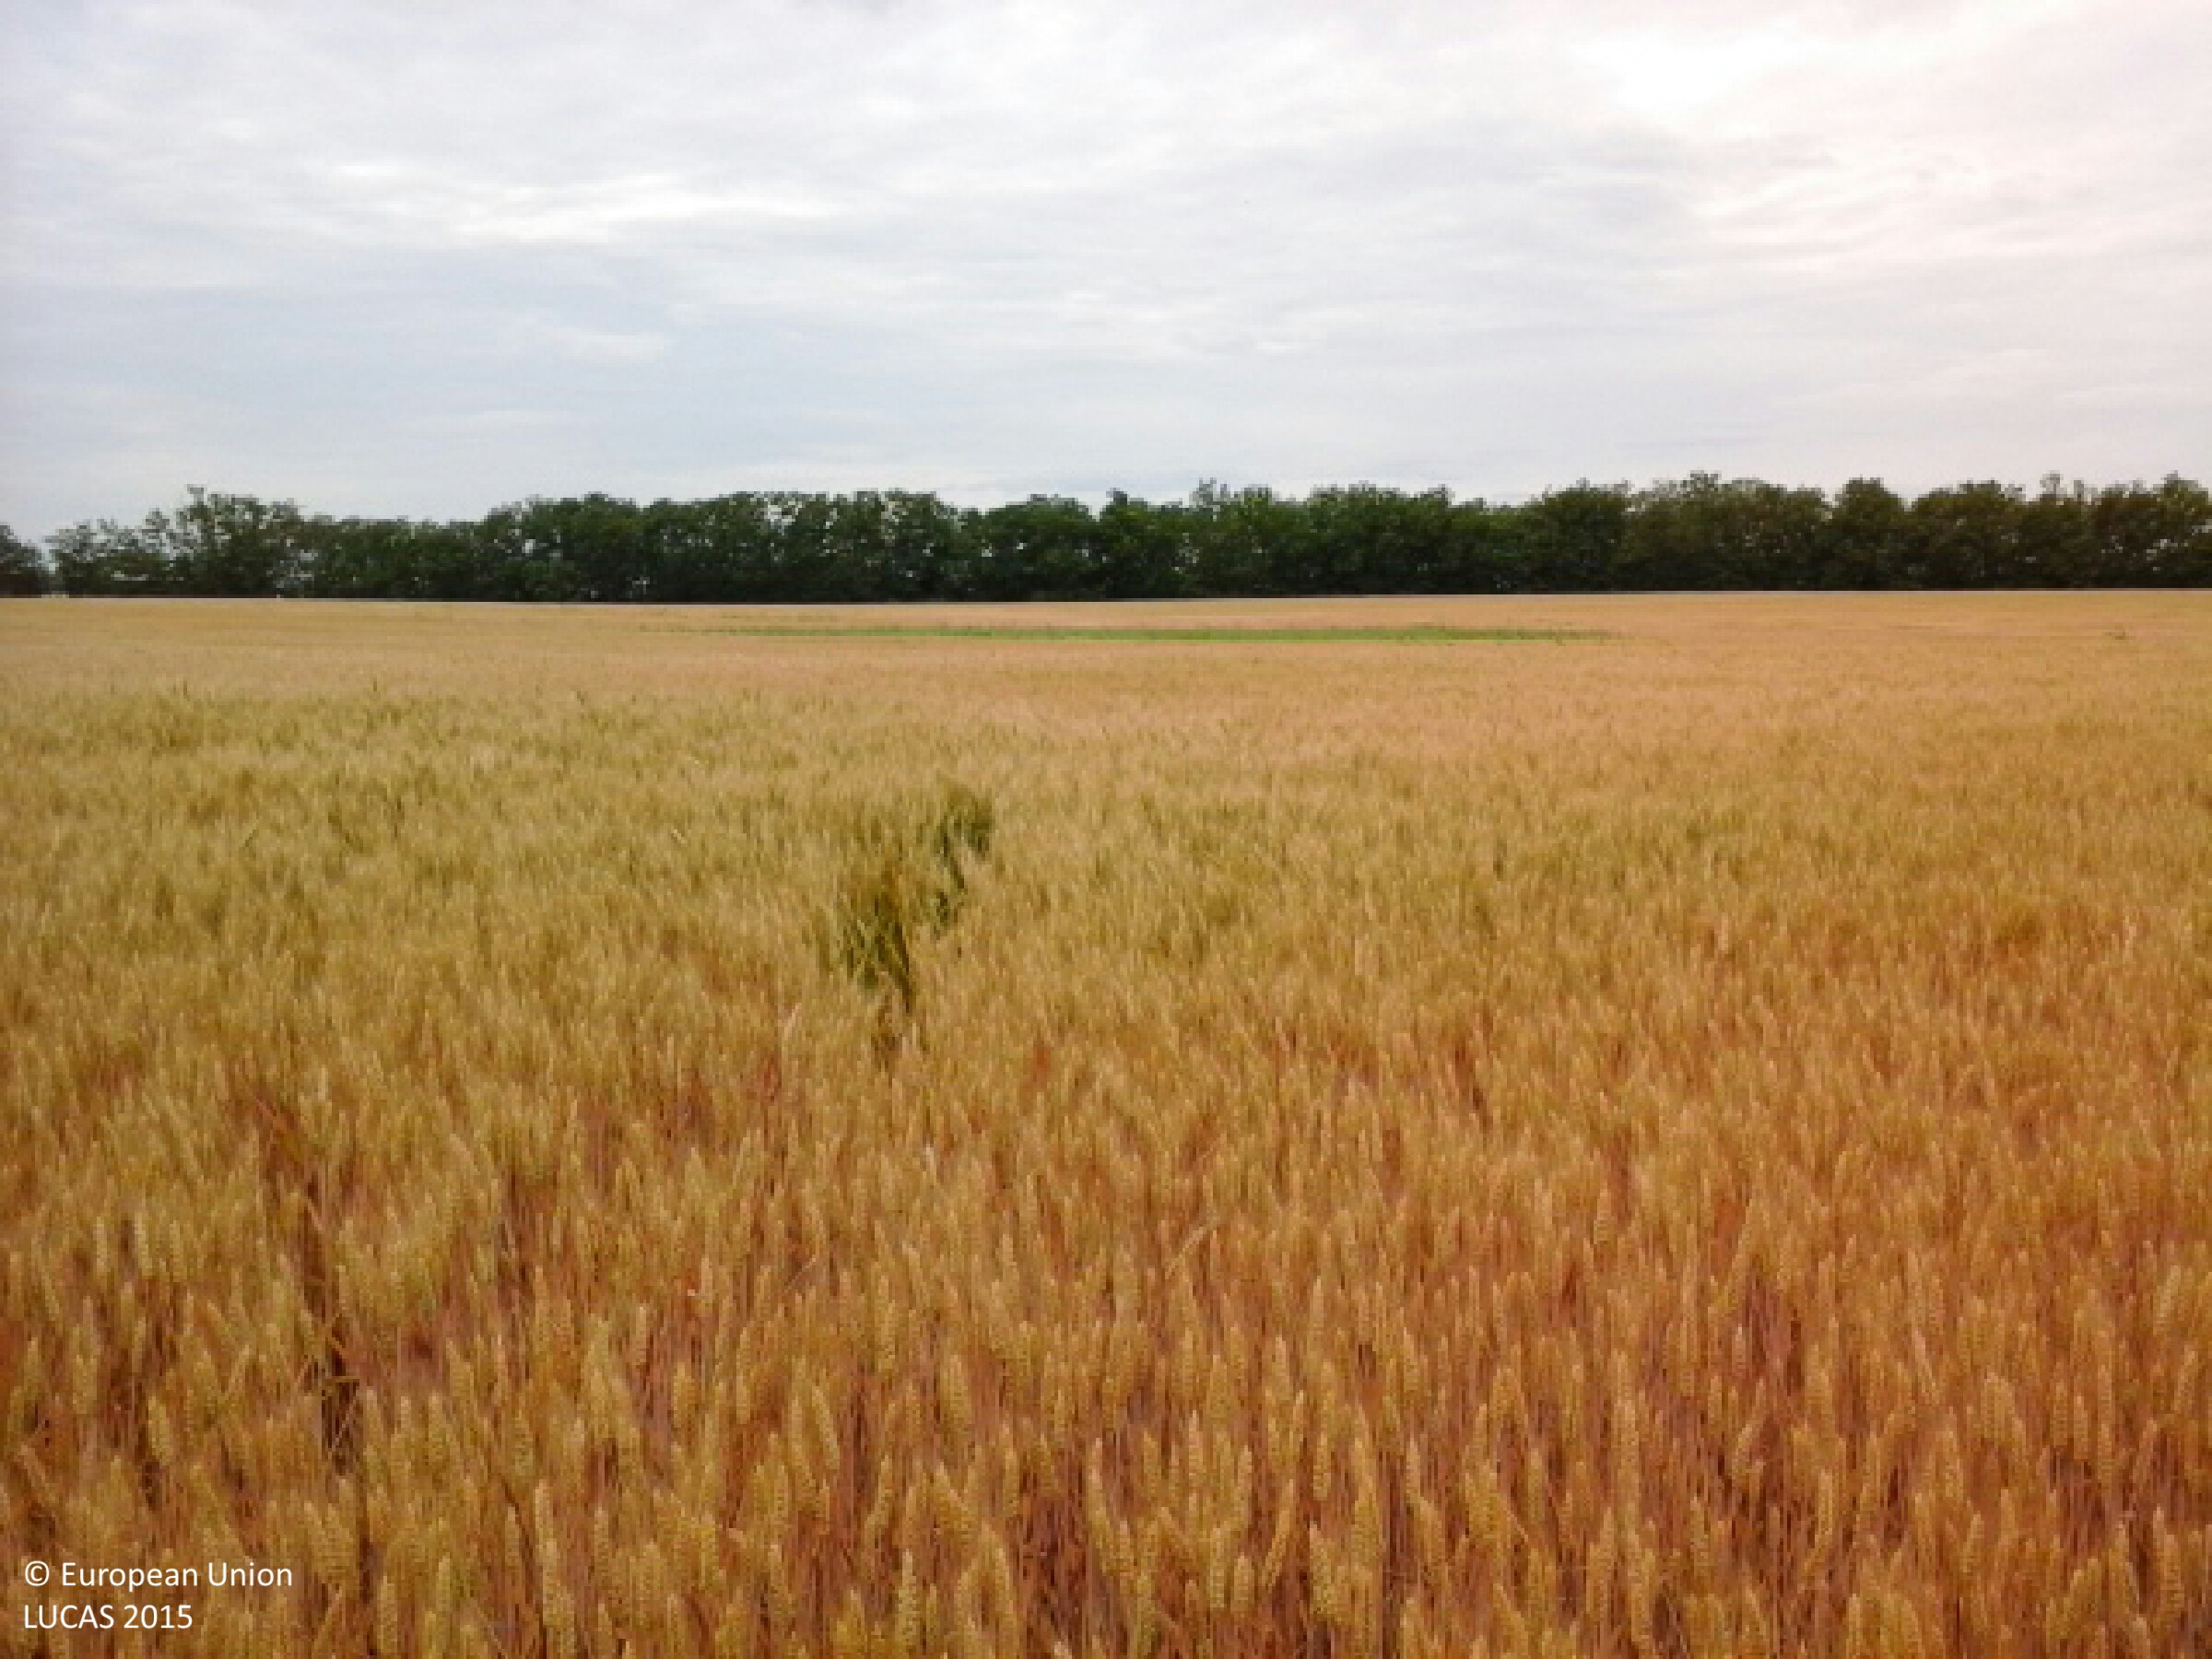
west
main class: Cropland
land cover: Triticale
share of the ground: > 75 %
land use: Agriculture (excluding fallow land and kitchen gardens)
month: June
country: HU
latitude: 47.9353
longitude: 21.4354
